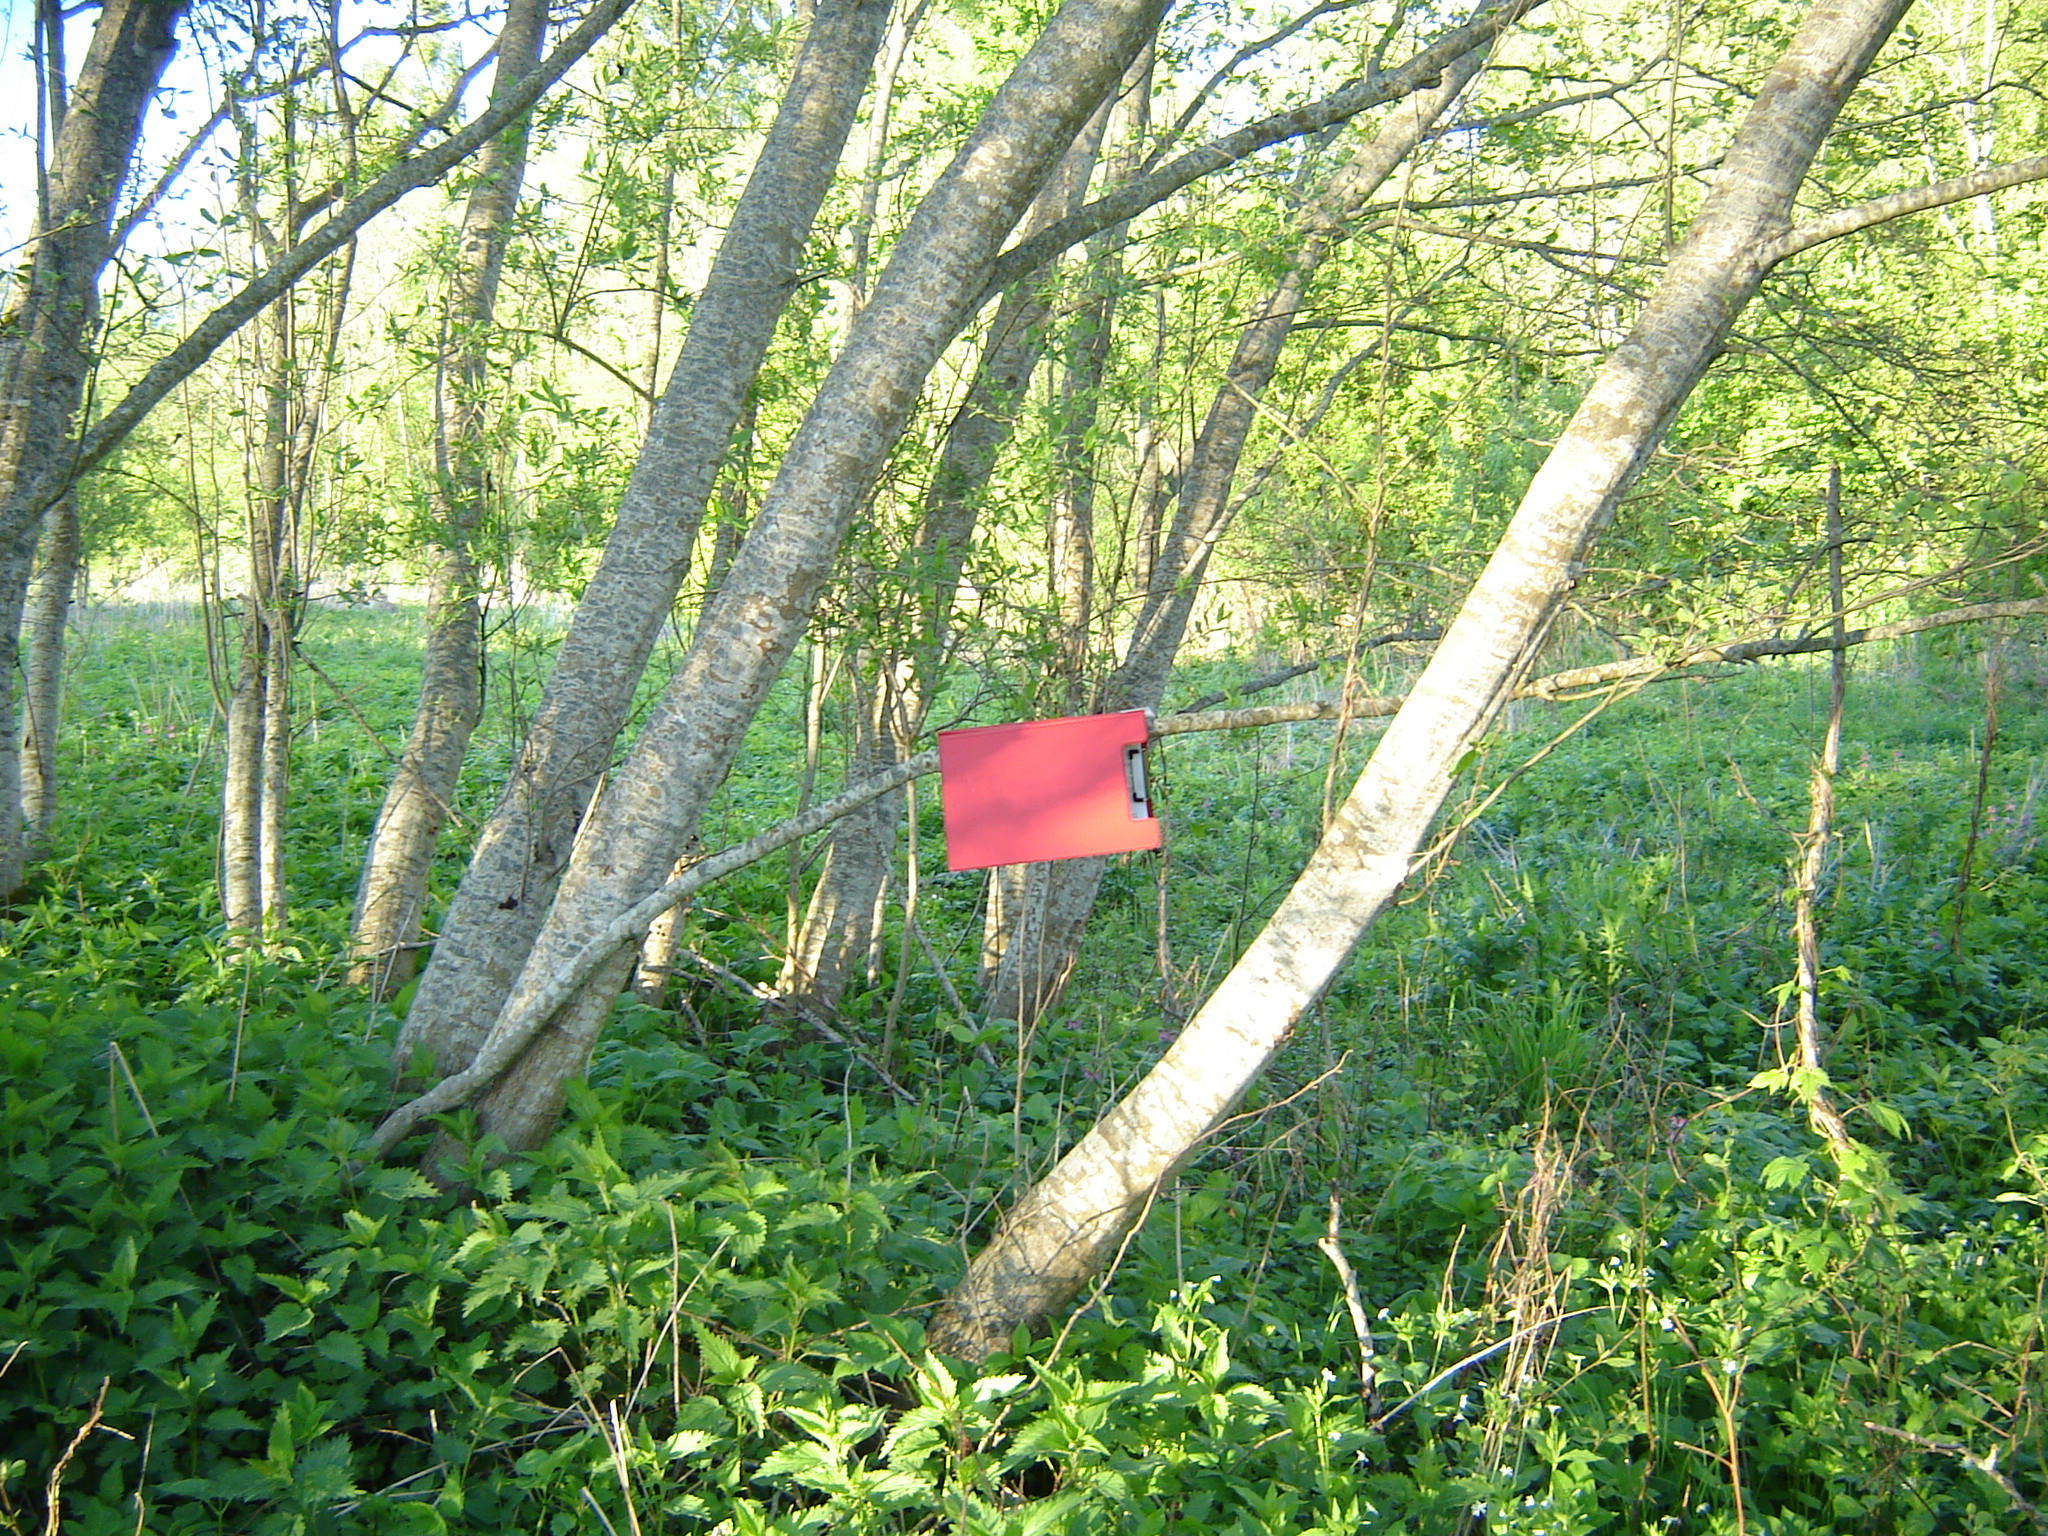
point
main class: Woodland
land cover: Broadleaved woodland
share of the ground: > 75 %
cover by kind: broadleaved forest trees 80 %, herbaceous plants 20 %
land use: Forestry
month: May
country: LT
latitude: 56.0734
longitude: 25.2656
